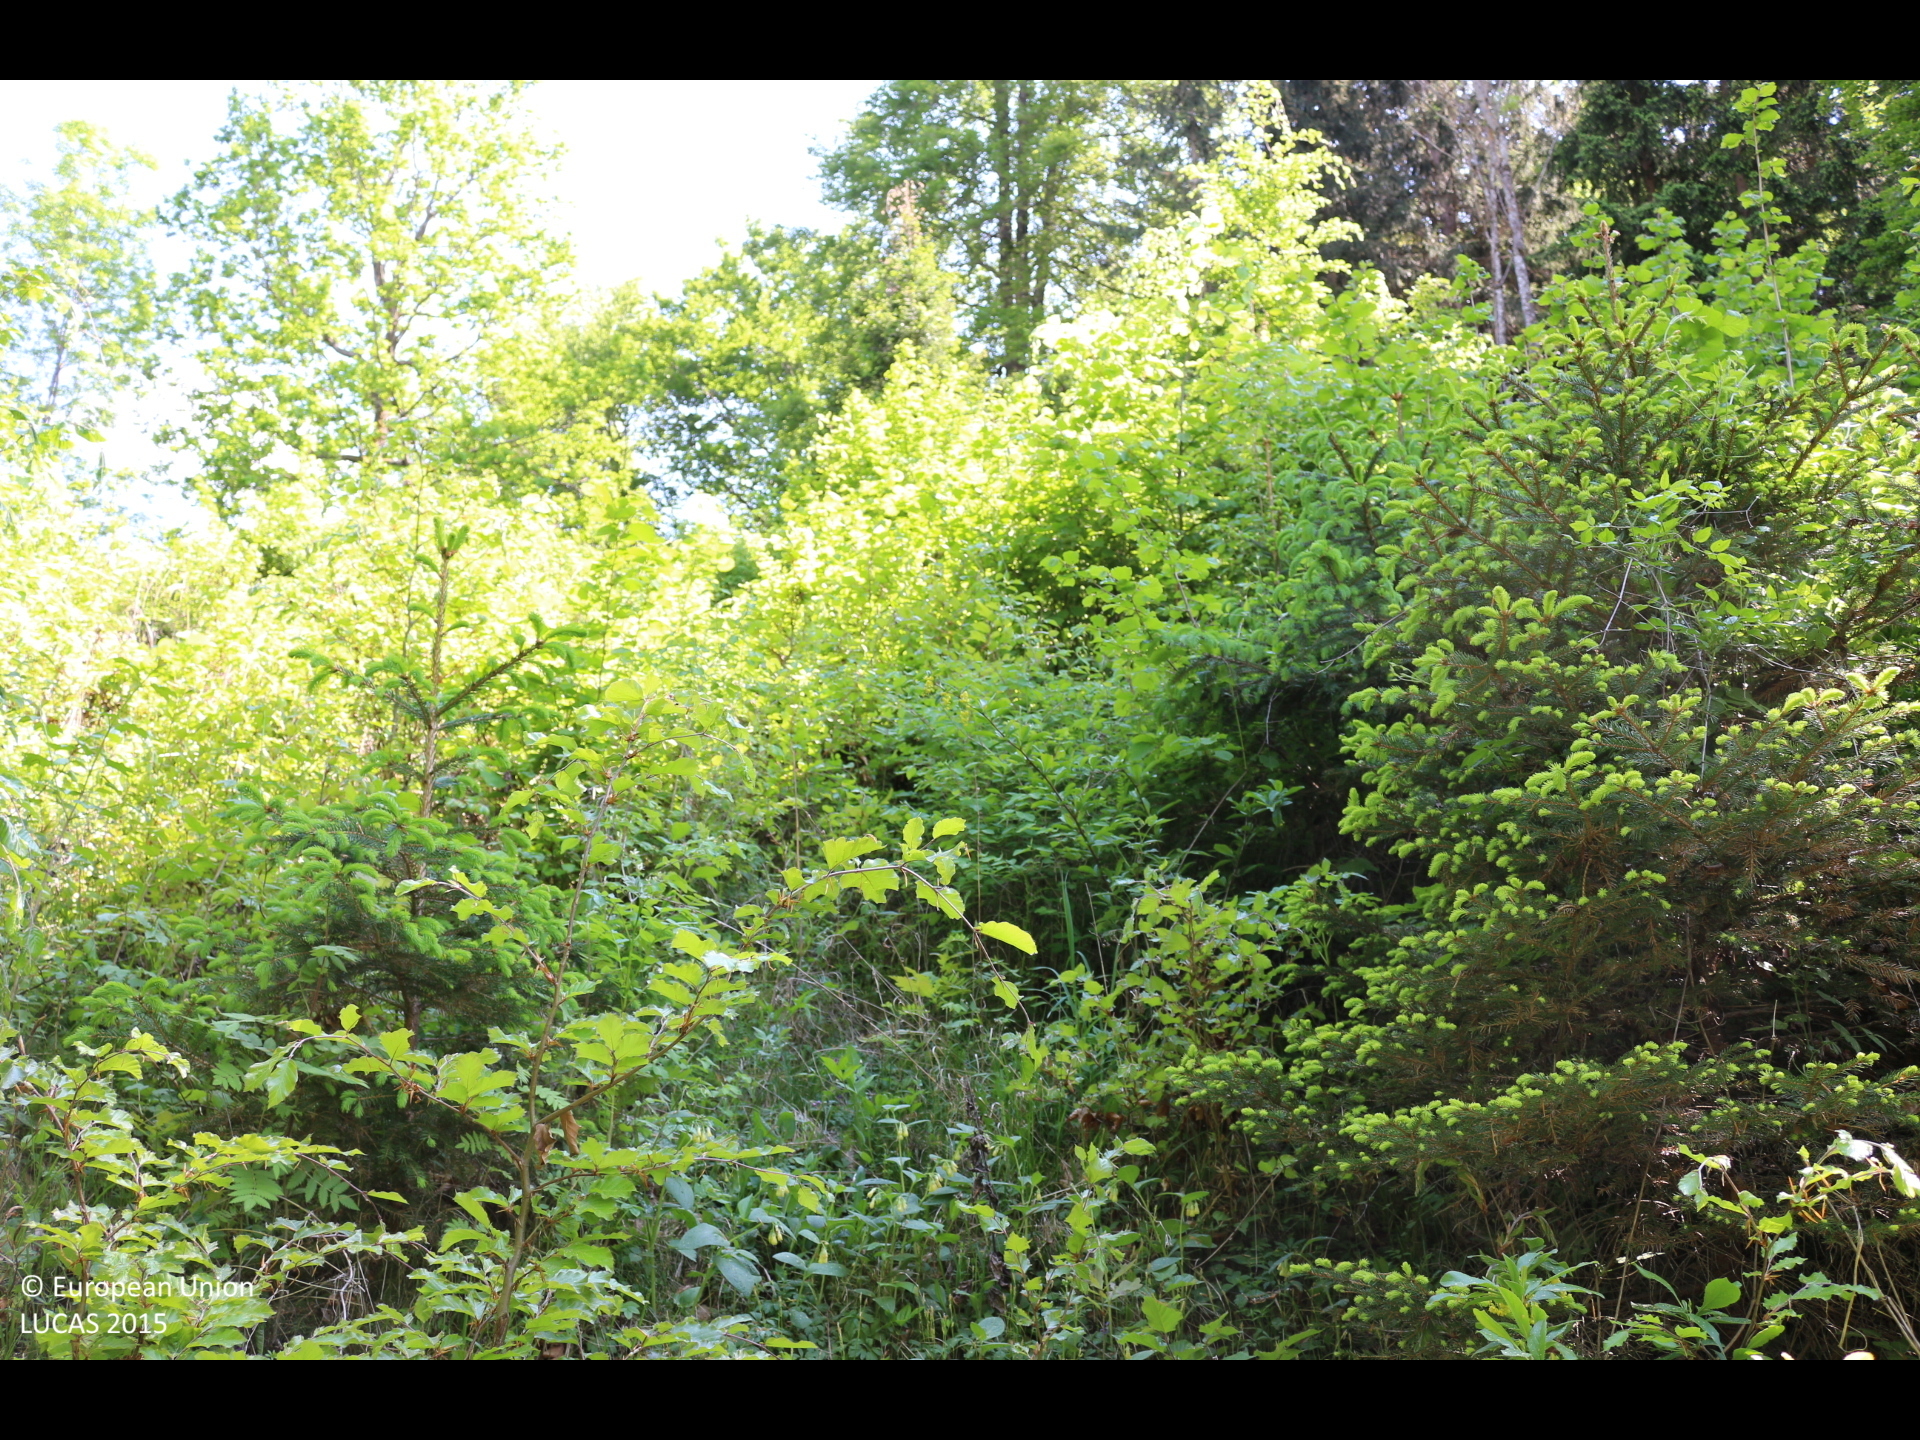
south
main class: Woodland
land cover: Spruce dominated mixed woodland
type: alpine coniferous forest
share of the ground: > 75 %
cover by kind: coniferous forest trees 40 %, broadleaved forest trees 40 %, shrubs 20 %
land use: Forestry
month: May
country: AT
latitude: 46.7822
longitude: 14.4381
